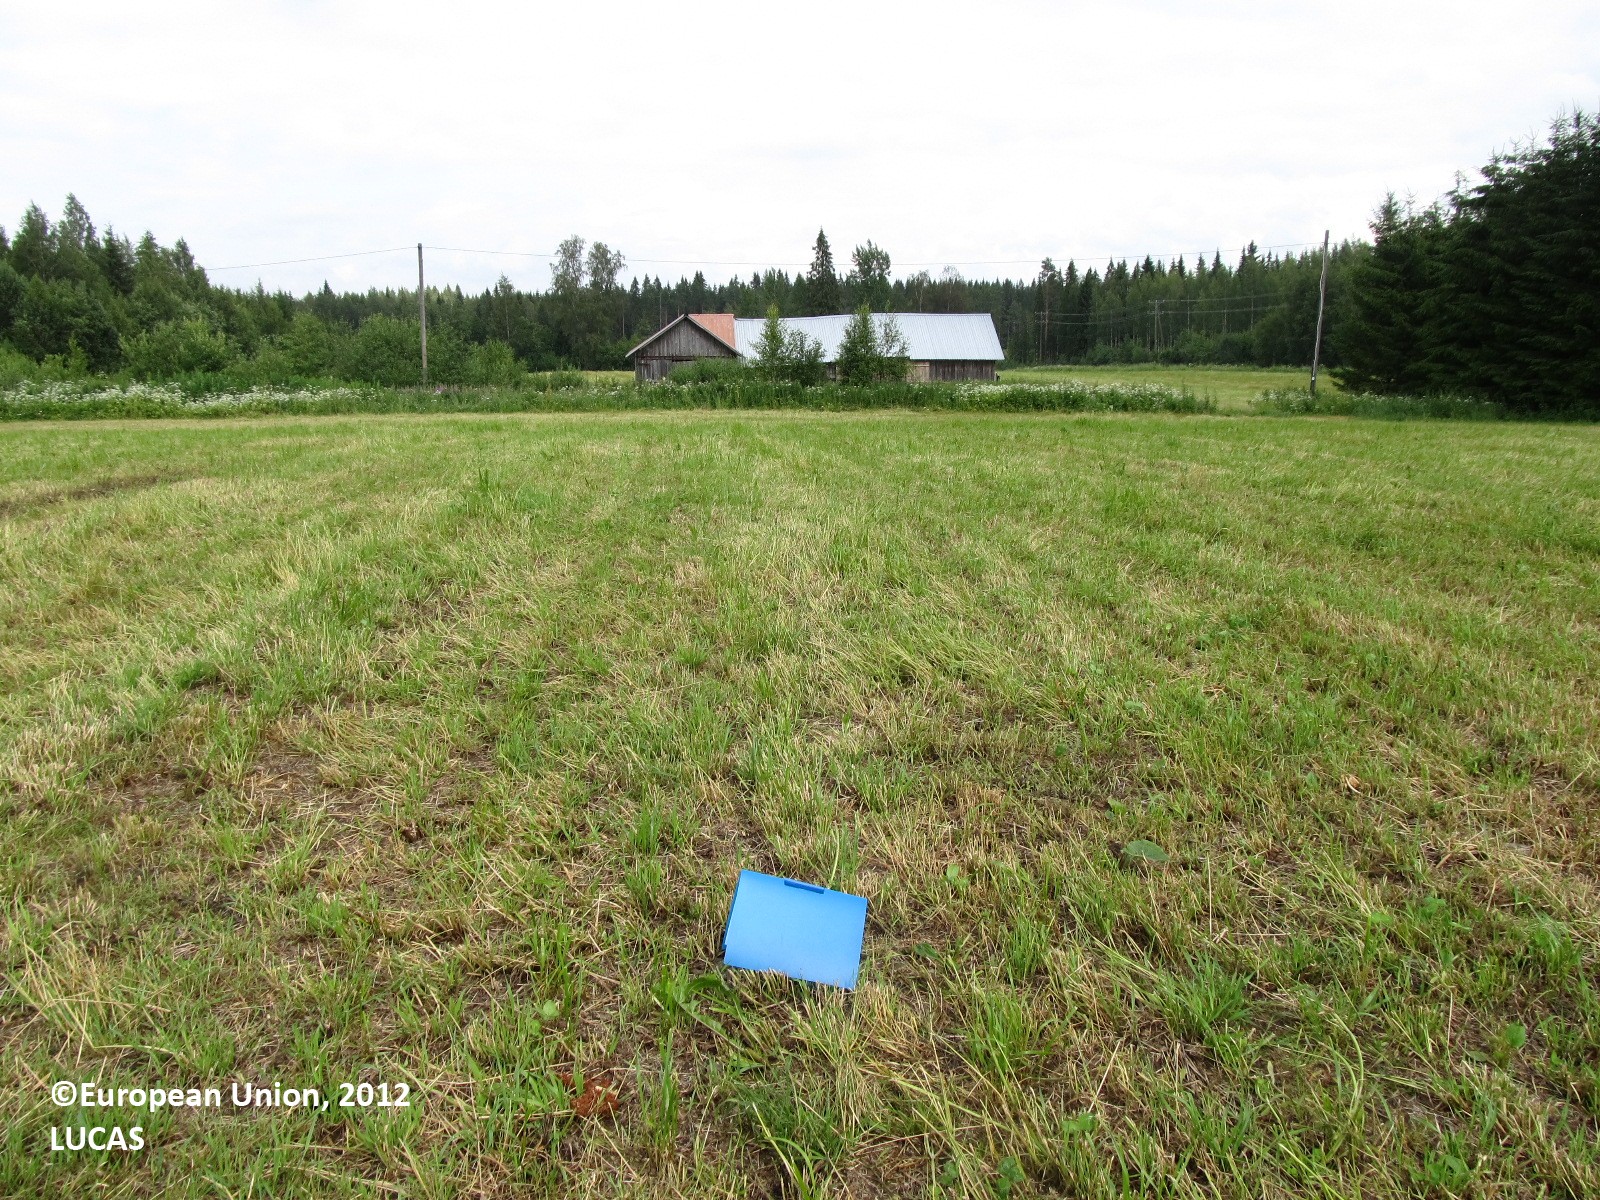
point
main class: Grassland
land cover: Grassland without tree/shrub cover
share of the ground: 50 - 75 %
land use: Fallow land
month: July
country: FI
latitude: 61.9196
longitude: 28.3113
